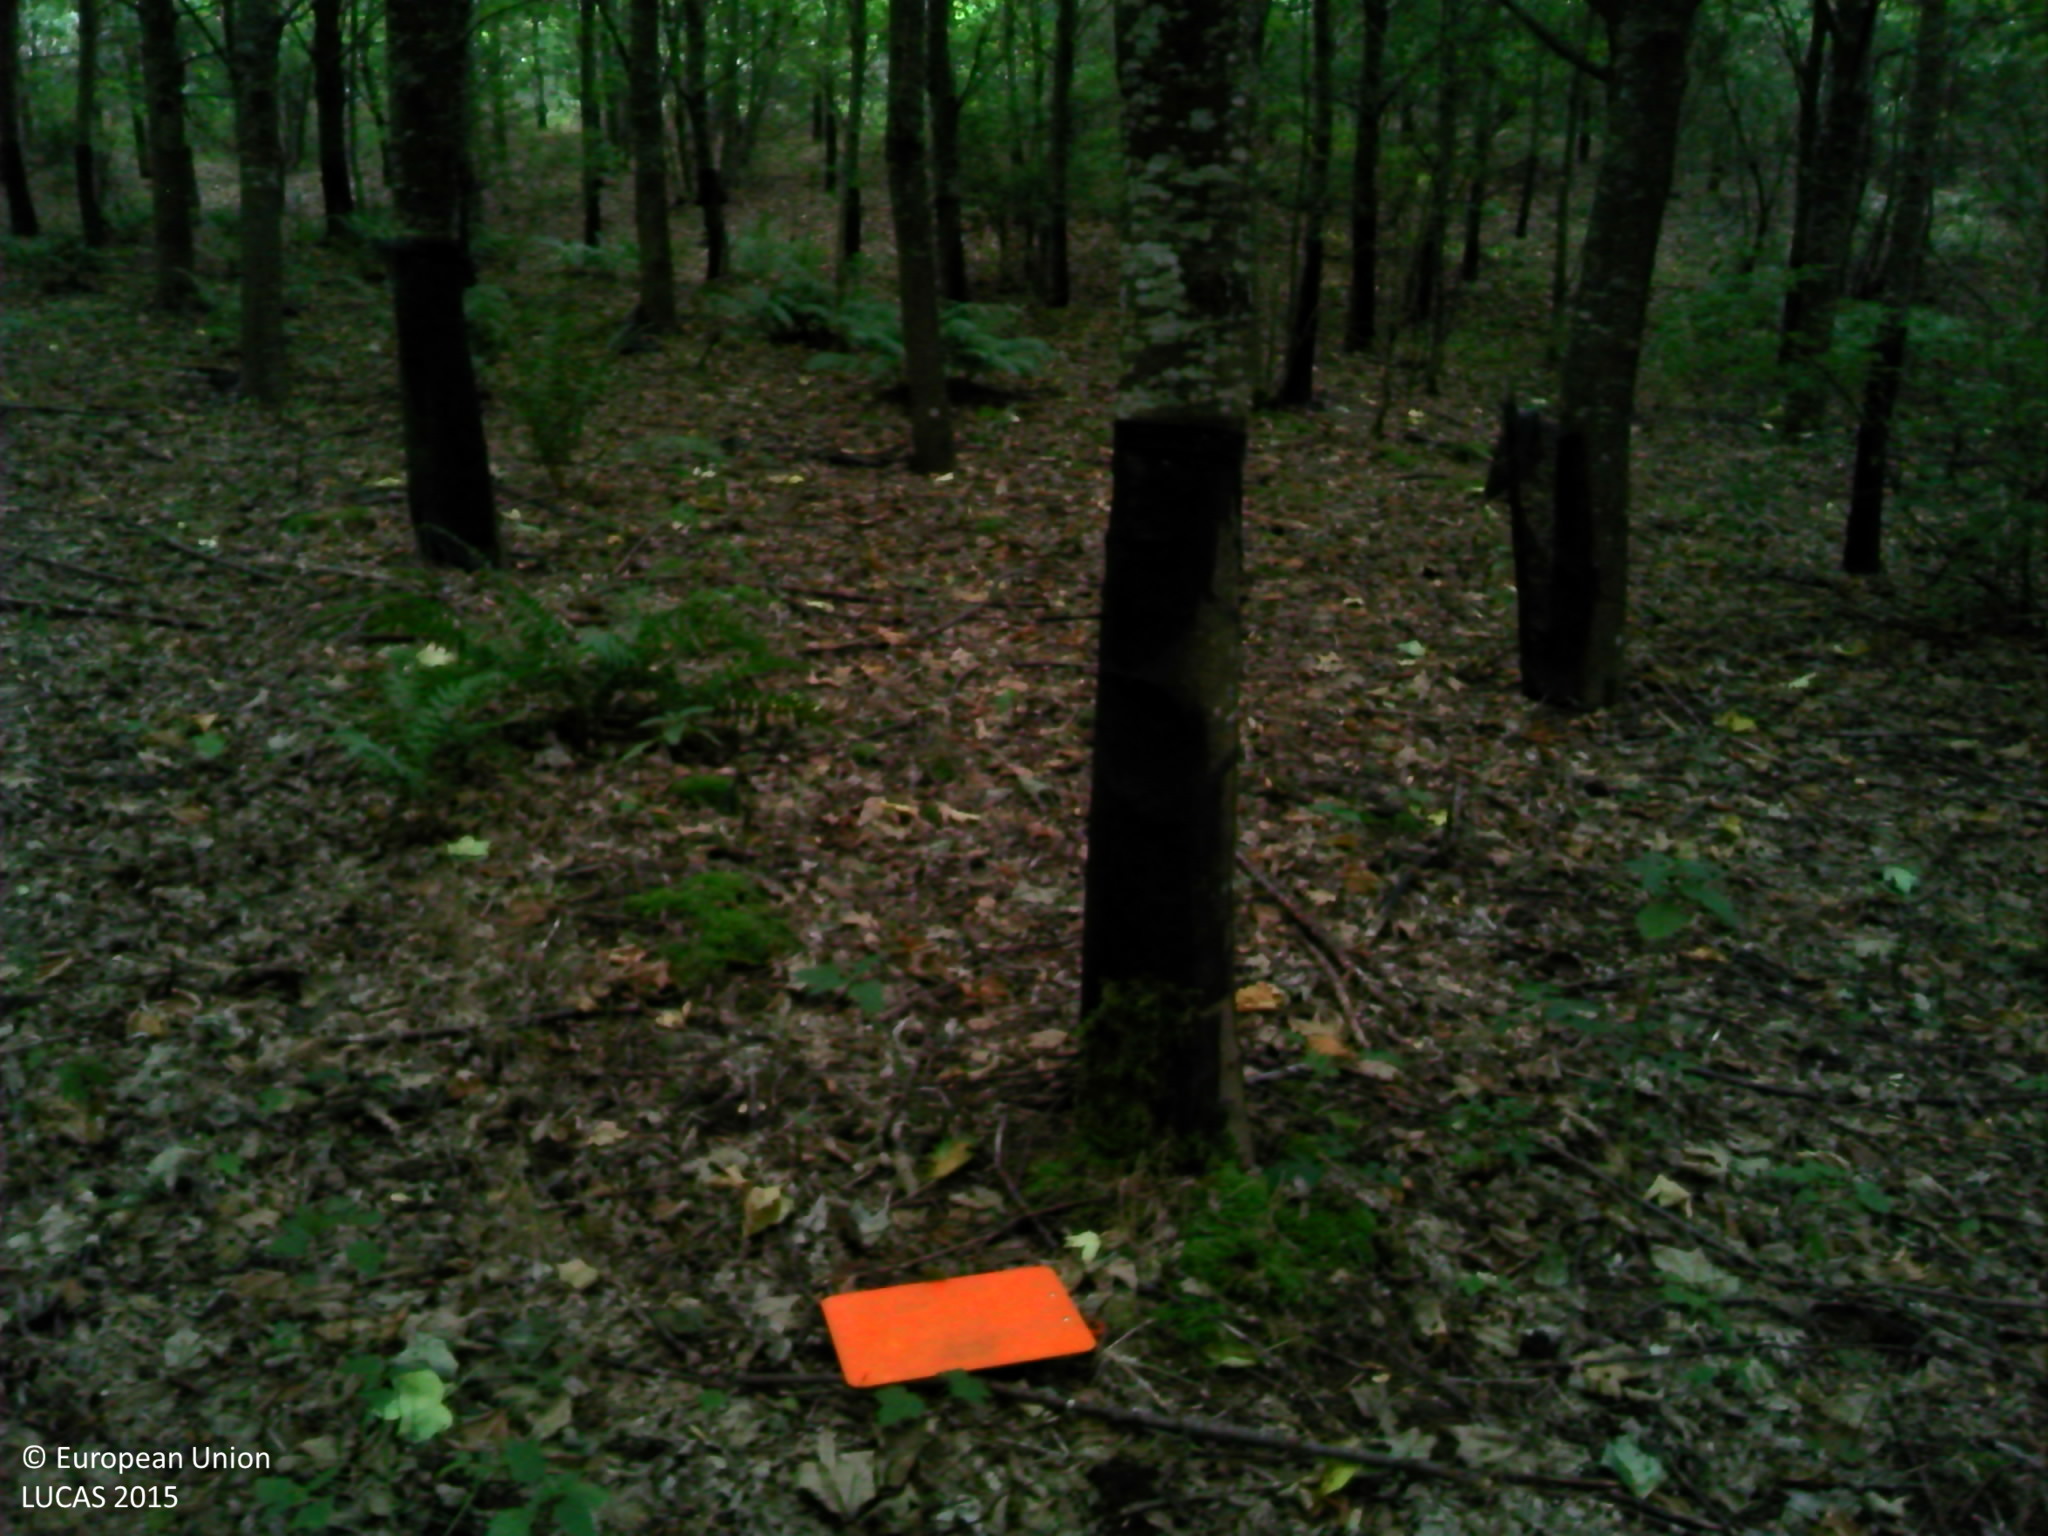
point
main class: Woodland
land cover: Broadleaved woodland
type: exotic forest
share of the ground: > 75 %
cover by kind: broadleaved forest trees 90 %, herbaceous plants 5 %
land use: Forestry
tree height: > 5 m
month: August
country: FR
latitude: 44.9119
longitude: 4.5462
